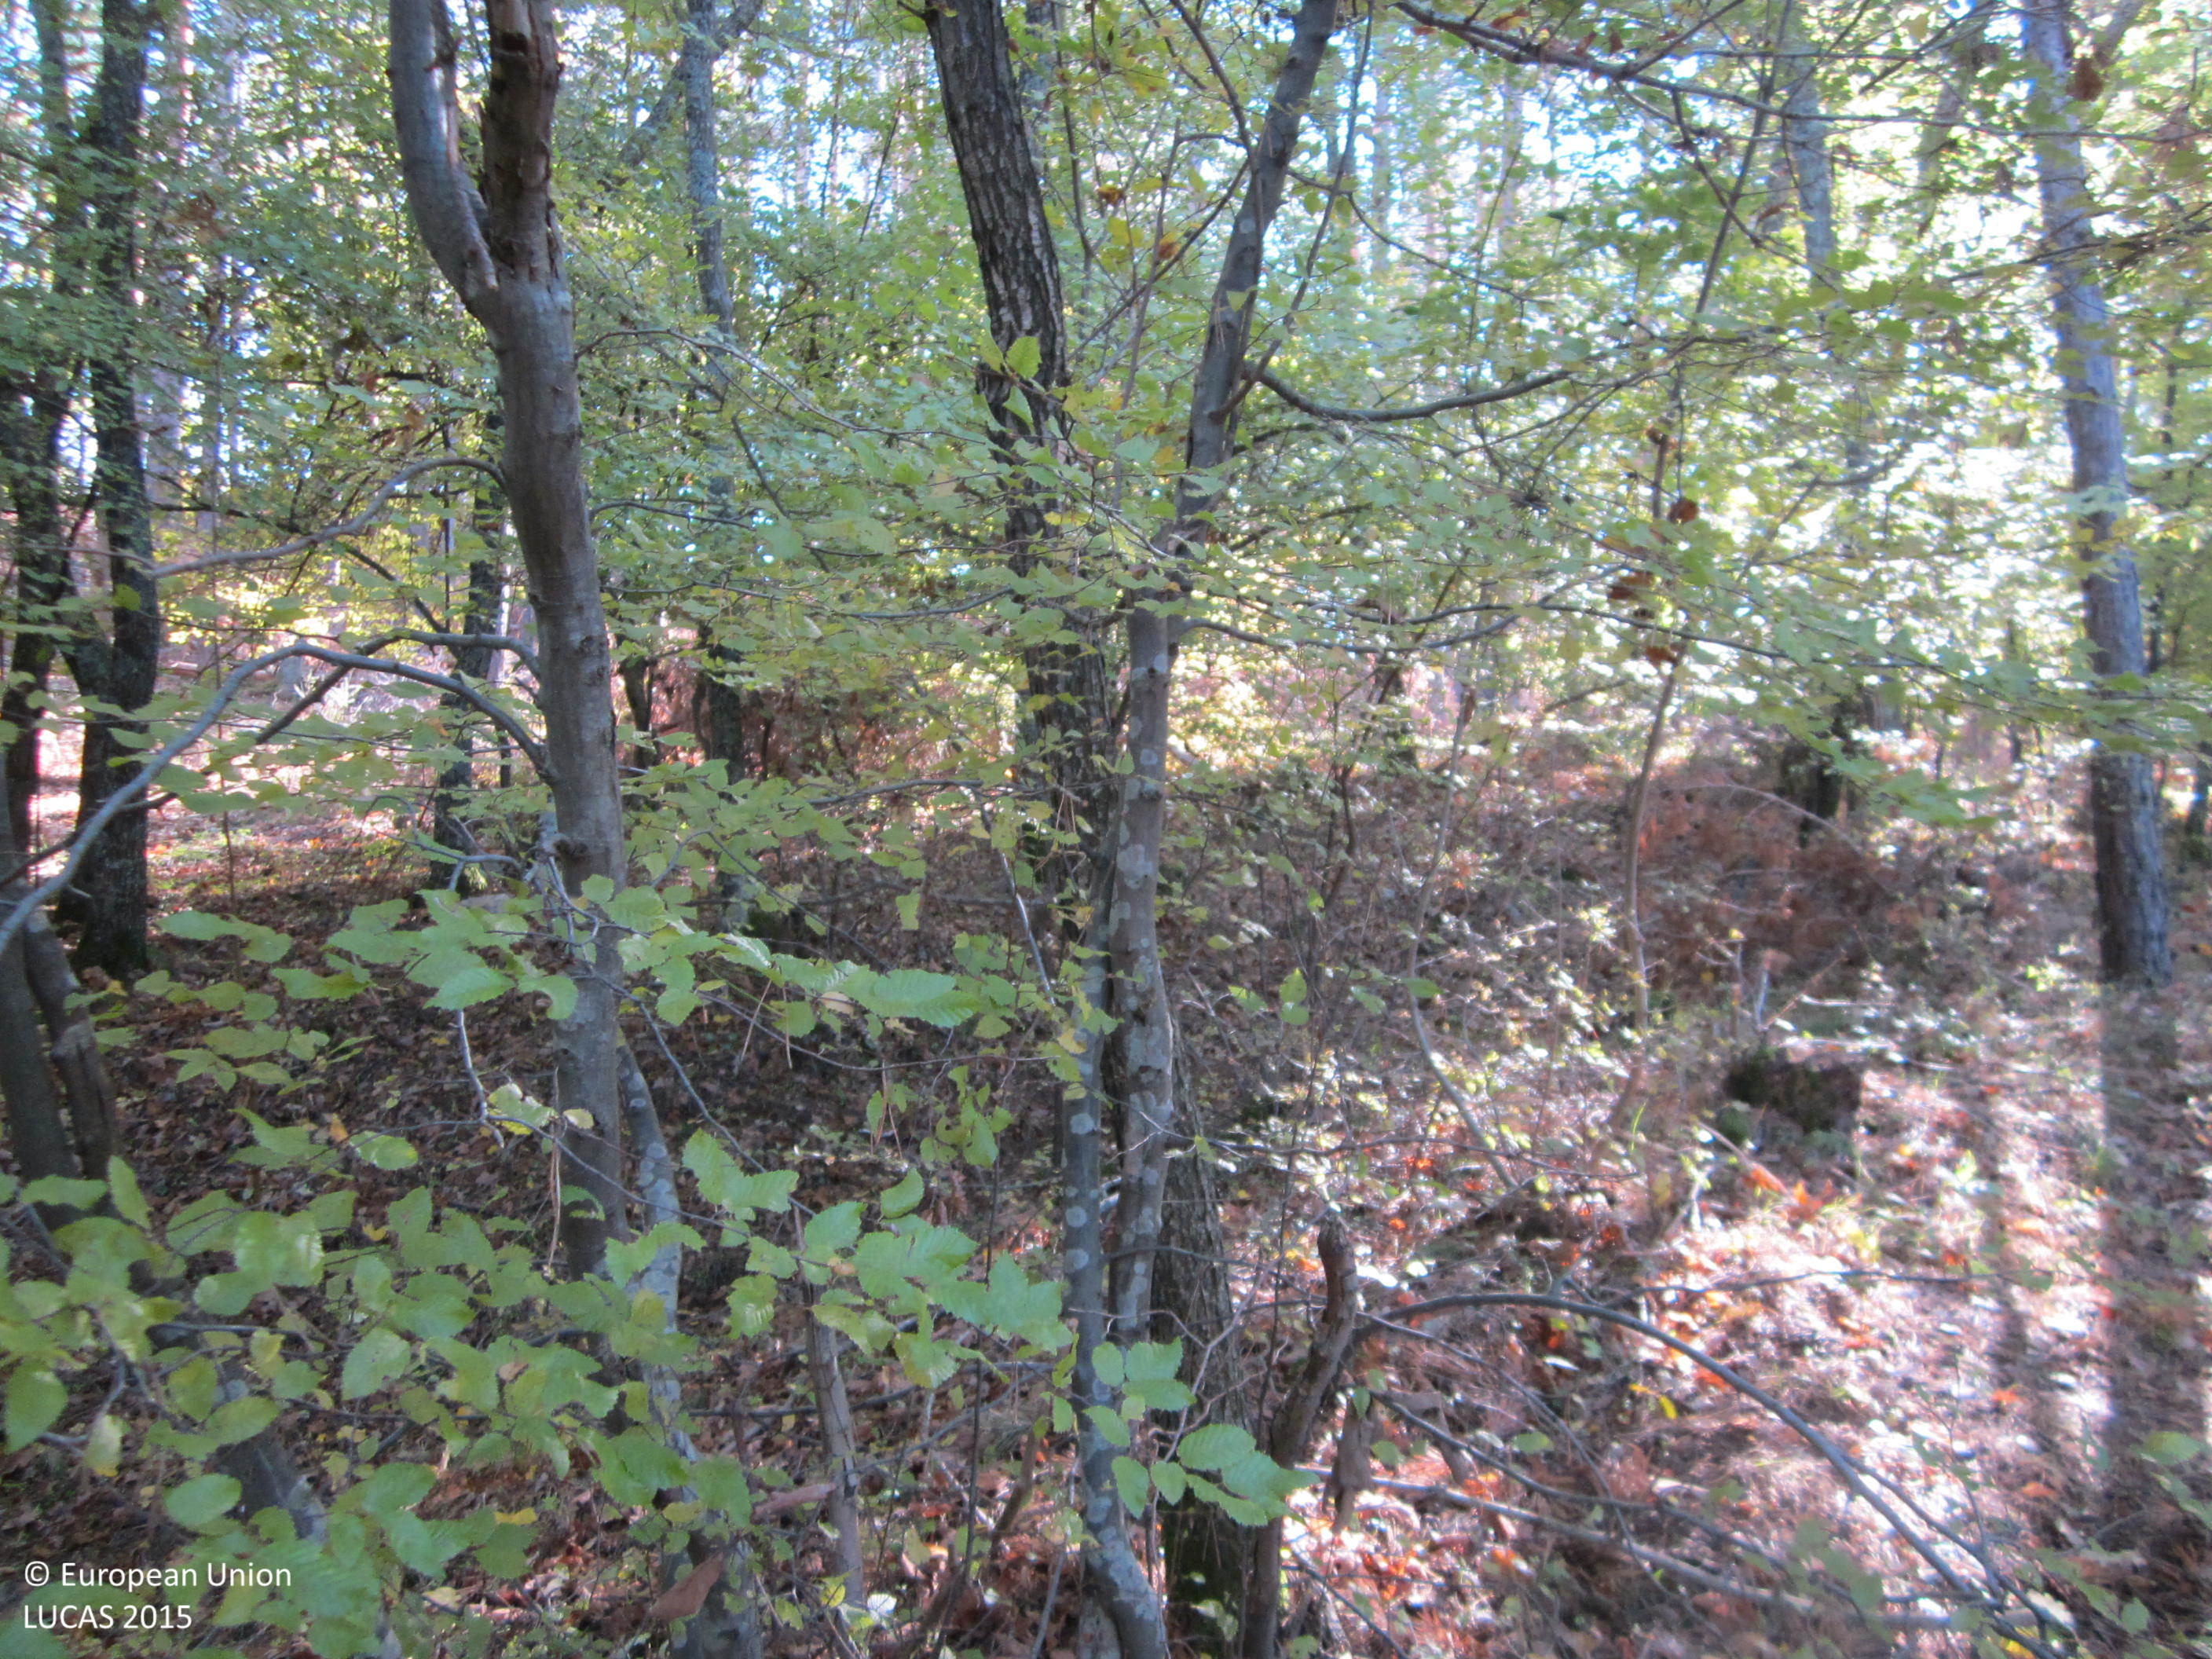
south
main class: Woodland
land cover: Pine dominated mixed woodland
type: hemiboreal forest and nemoral coniferous forest and mixed broadleaved-coniferous forest
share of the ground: > 75 %
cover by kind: coniferous forest trees 60 %, broadleaved forest trees 20 %, herbaceous plants 10 %, unconsolidated bare surface 10 %
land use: Forestry
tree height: > 5 m
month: November
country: BG
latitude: 41.4060
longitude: 25.7924
